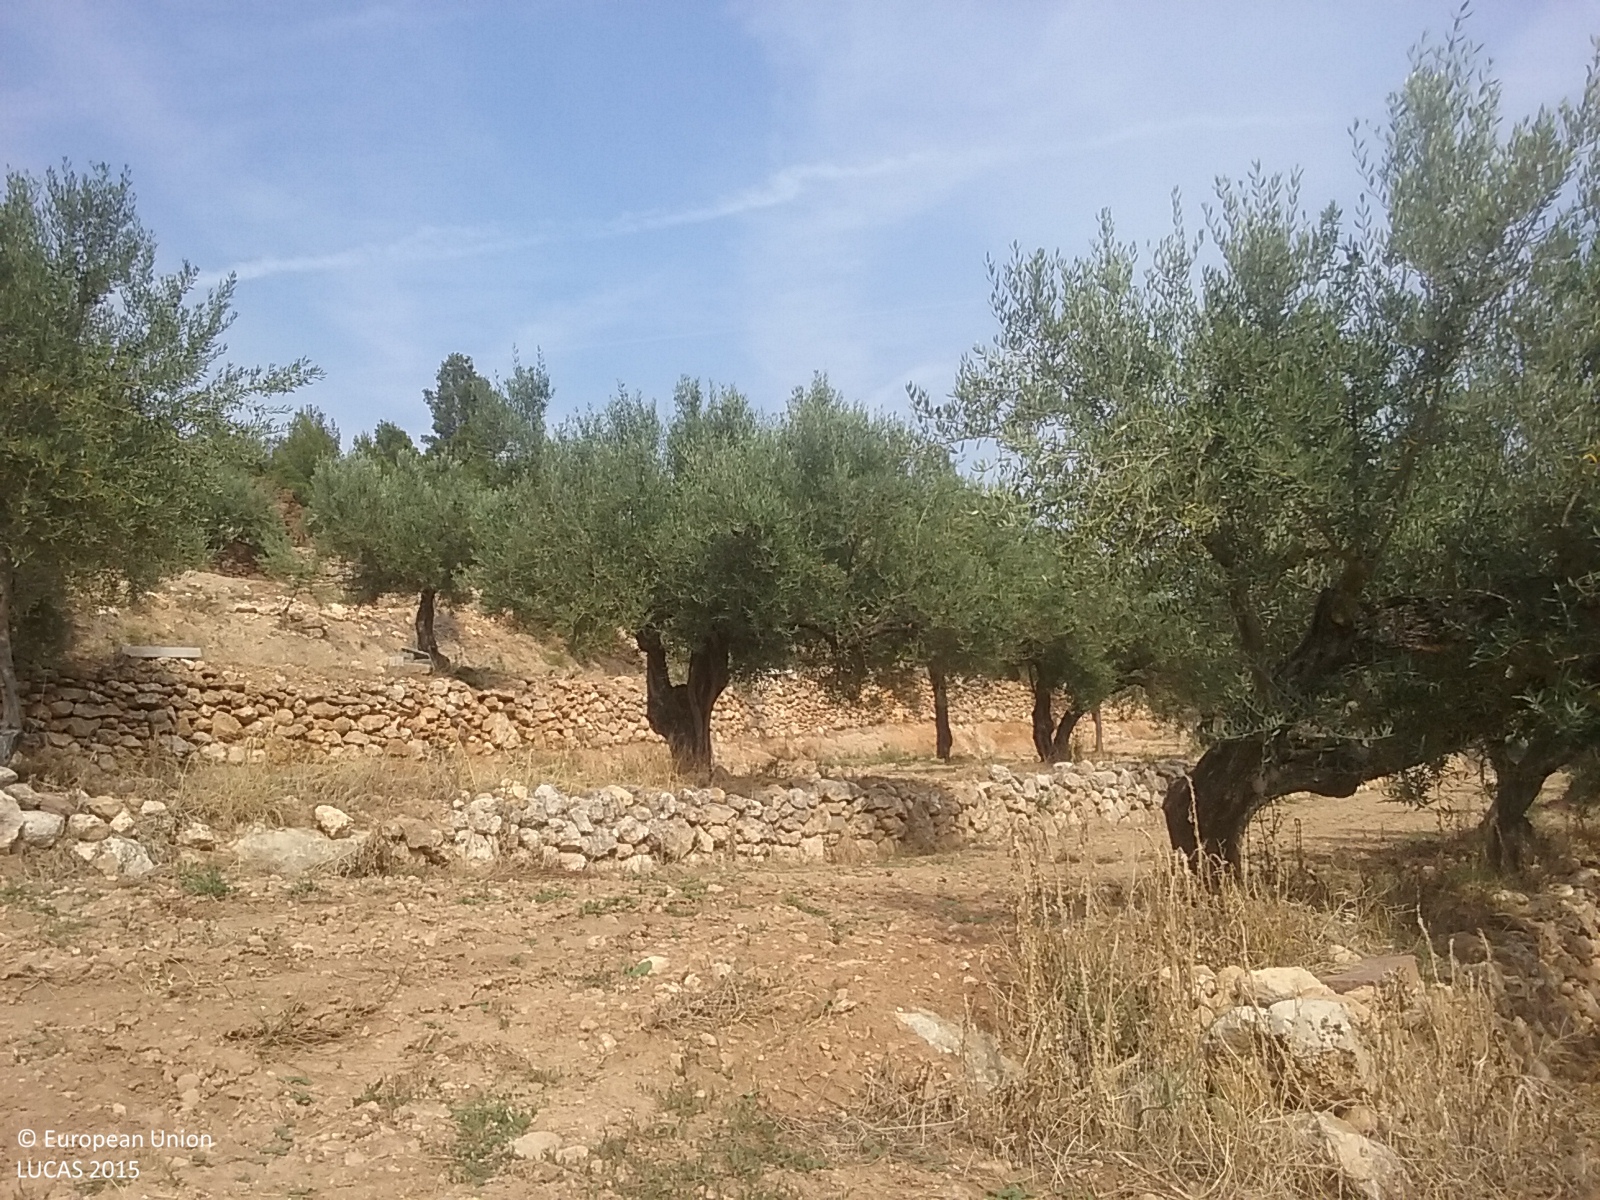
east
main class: Cropland
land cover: Nuts trees
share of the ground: 10 - 25 %
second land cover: Spontaneously vegetated surfaces
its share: 10 - 25 %
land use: Agriculture (excluding fallow land and kitchen gardens)
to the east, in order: Nuts trees; Spontaneously vegetated surfaces; Pine dominated mixed woodland; Tracks; Olive groves; Shrubland with sparse tree cover; Spontaneously vegetated surfaces; Dry stone walls; Olive groves; Dry stone walls; Shrubland with sparse tree cover; Dry stone walls; Shrubland with sparse tree cover; Rivers and streams; Shrubland with sparse tree cover; Pine dominated mixed woodland; Shrubland with sparse tree cover; Ditches and canals; Dry stone walls; Olive groves
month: July
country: ES
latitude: 39.9166
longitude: -0.7083
